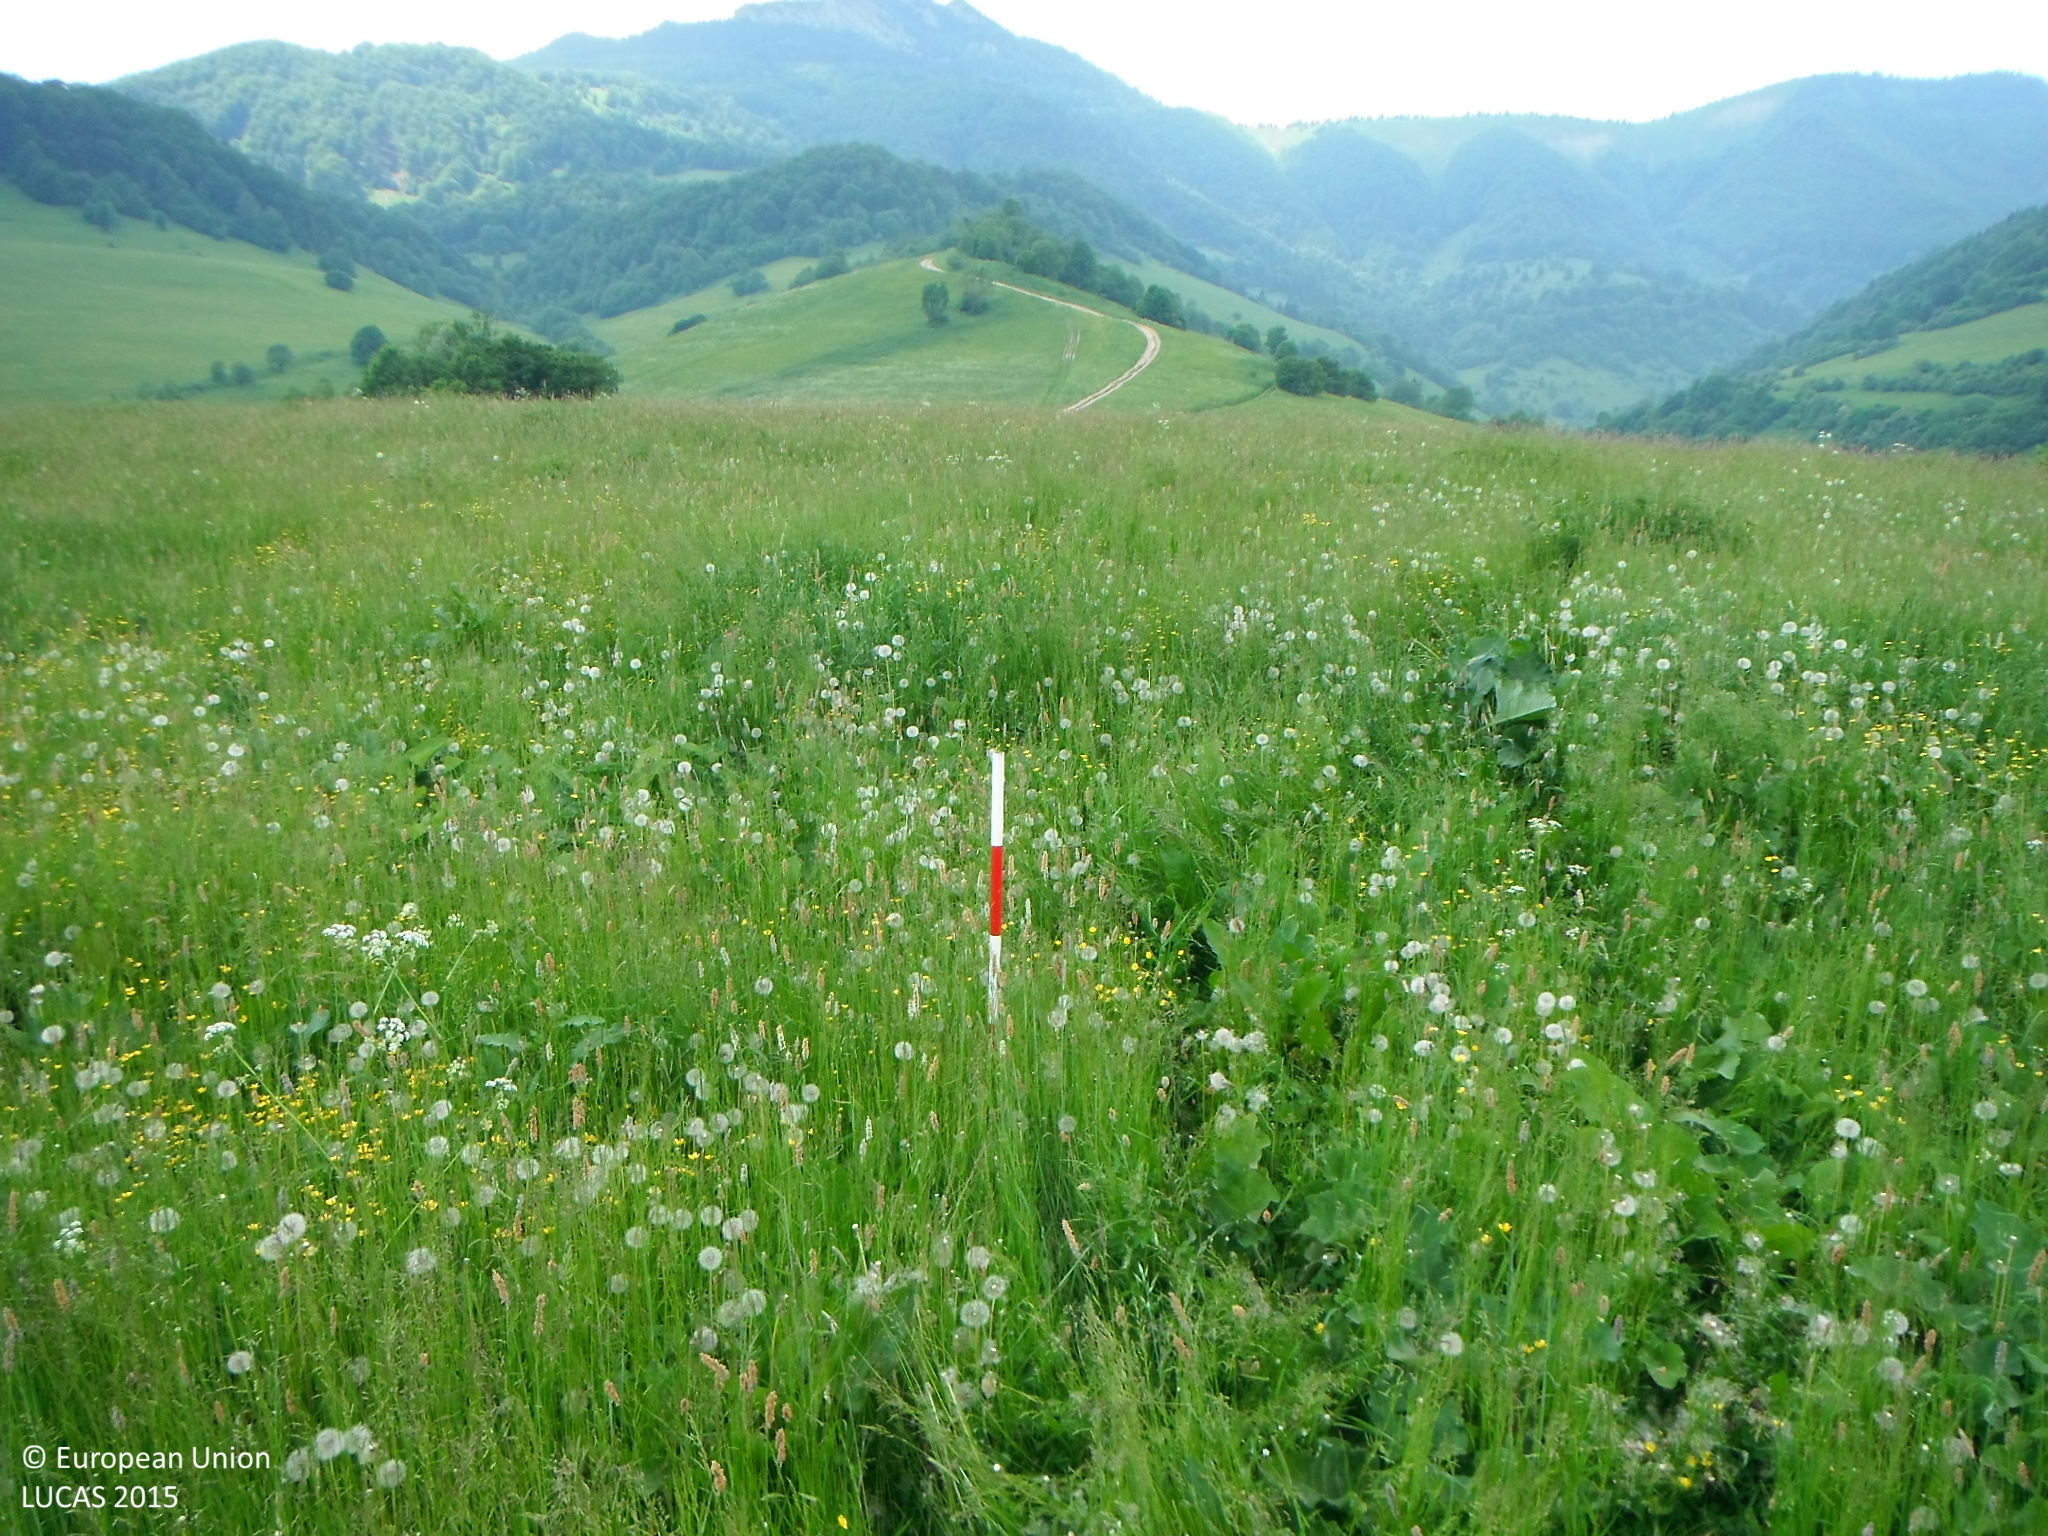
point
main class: Grassland
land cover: Grassland without tree/shrub cover
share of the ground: > 75 %
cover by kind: herbaceous plants 100 %
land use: Agriculture (excluding fallow land and kitchen gardens)
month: June
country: SK
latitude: 48.9261
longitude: 19.1812
